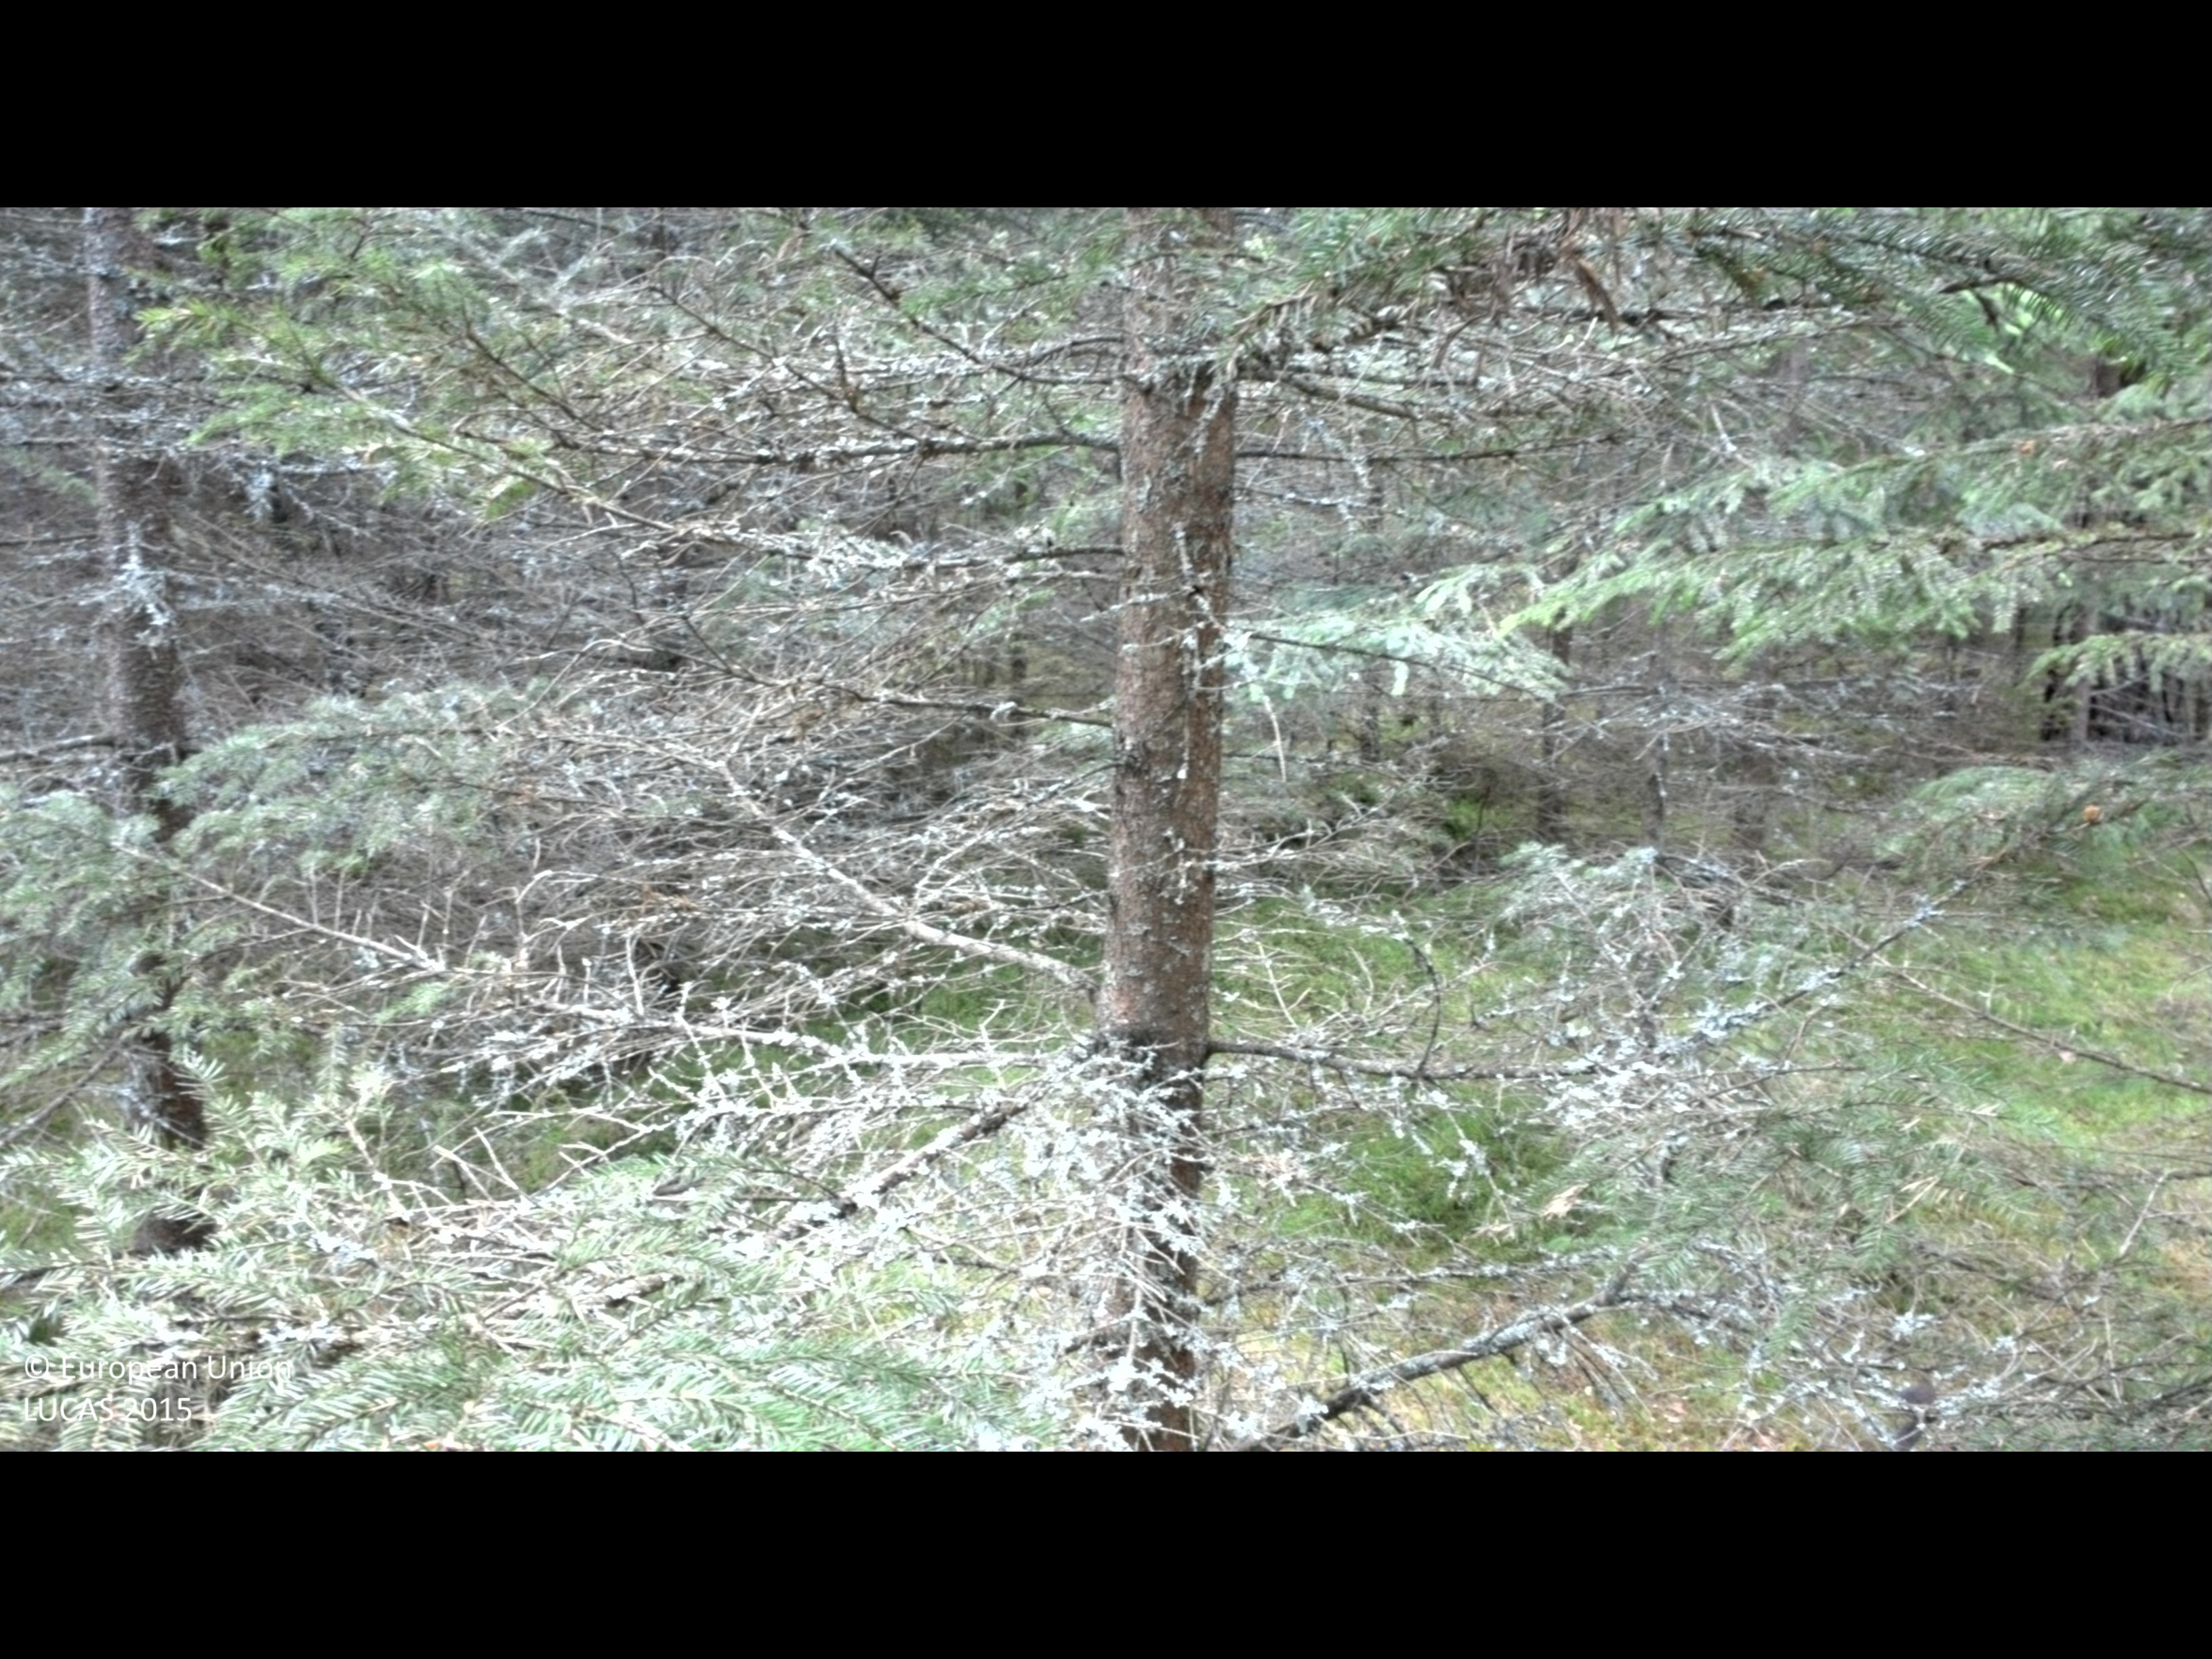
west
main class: Woodland
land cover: Spruce dominated coniferous woodland
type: boreal forest
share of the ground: > 75 %
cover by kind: coniferous forest trees 80 %, broadleaved forest trees 10 %, lichens and mosses 10 %
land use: Forestry
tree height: > 5 m
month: July
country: SE
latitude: 56.4601
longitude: 14.2329
